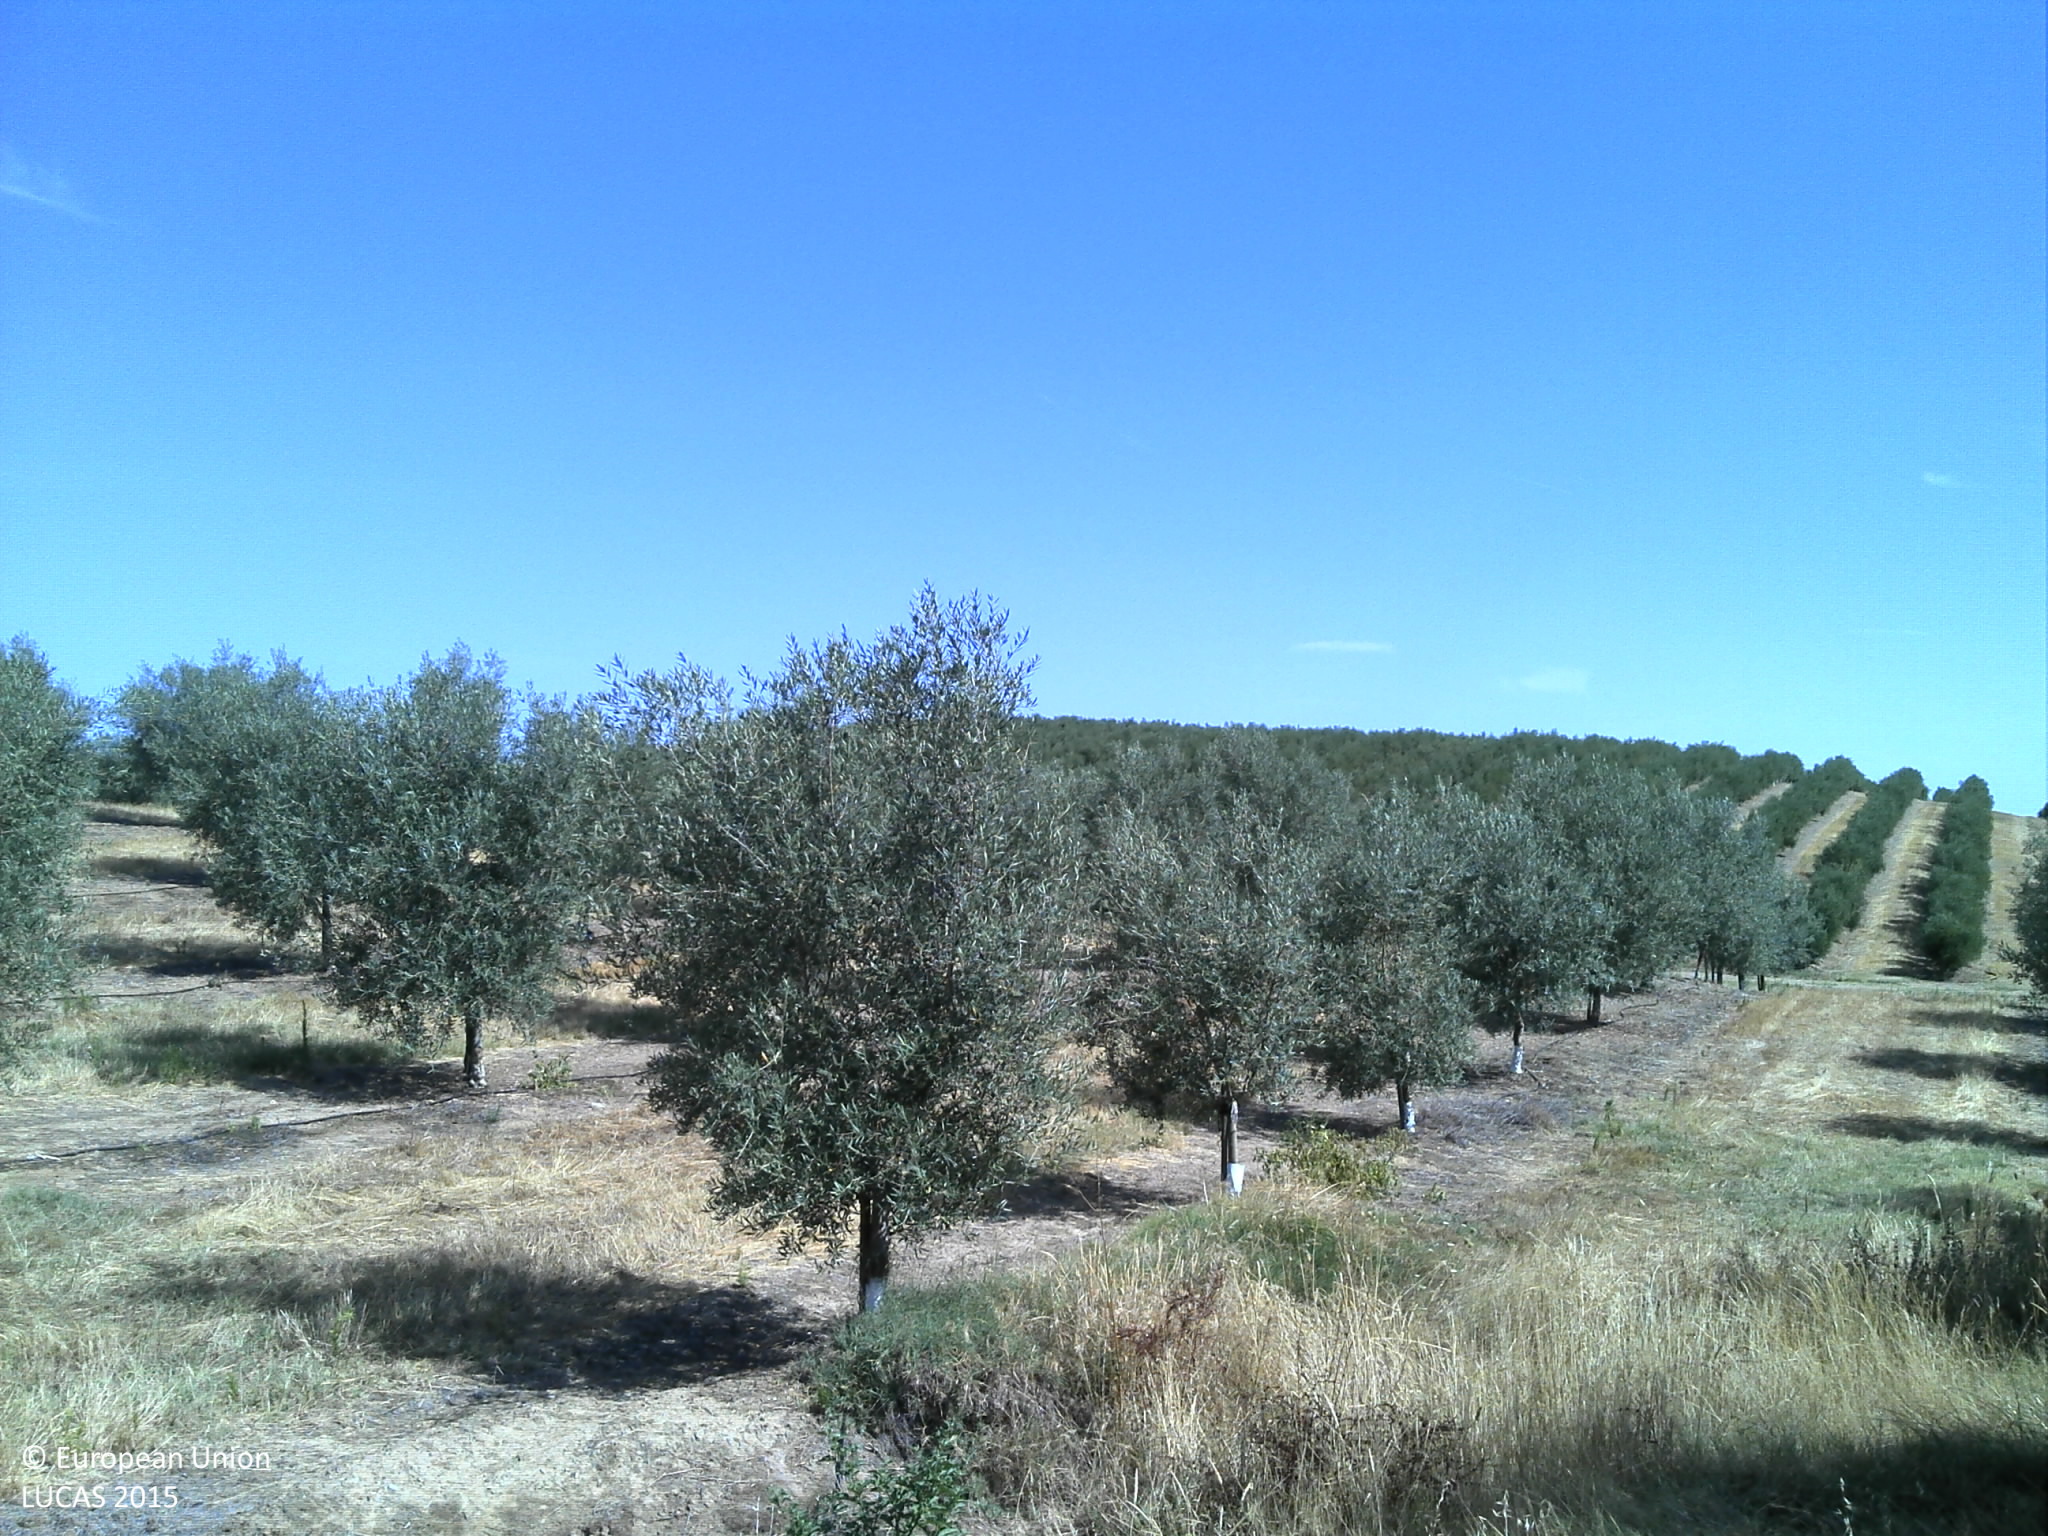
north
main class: Cropland
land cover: Olive groves
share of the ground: 10 - 25 %
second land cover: Grassland without tree/shrub cover
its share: 25 - 50 %
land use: Agriculture (excluding fallow land and kitchen gardens)
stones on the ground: < 10 %
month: July
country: PT
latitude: 38.4426
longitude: -7.6875
